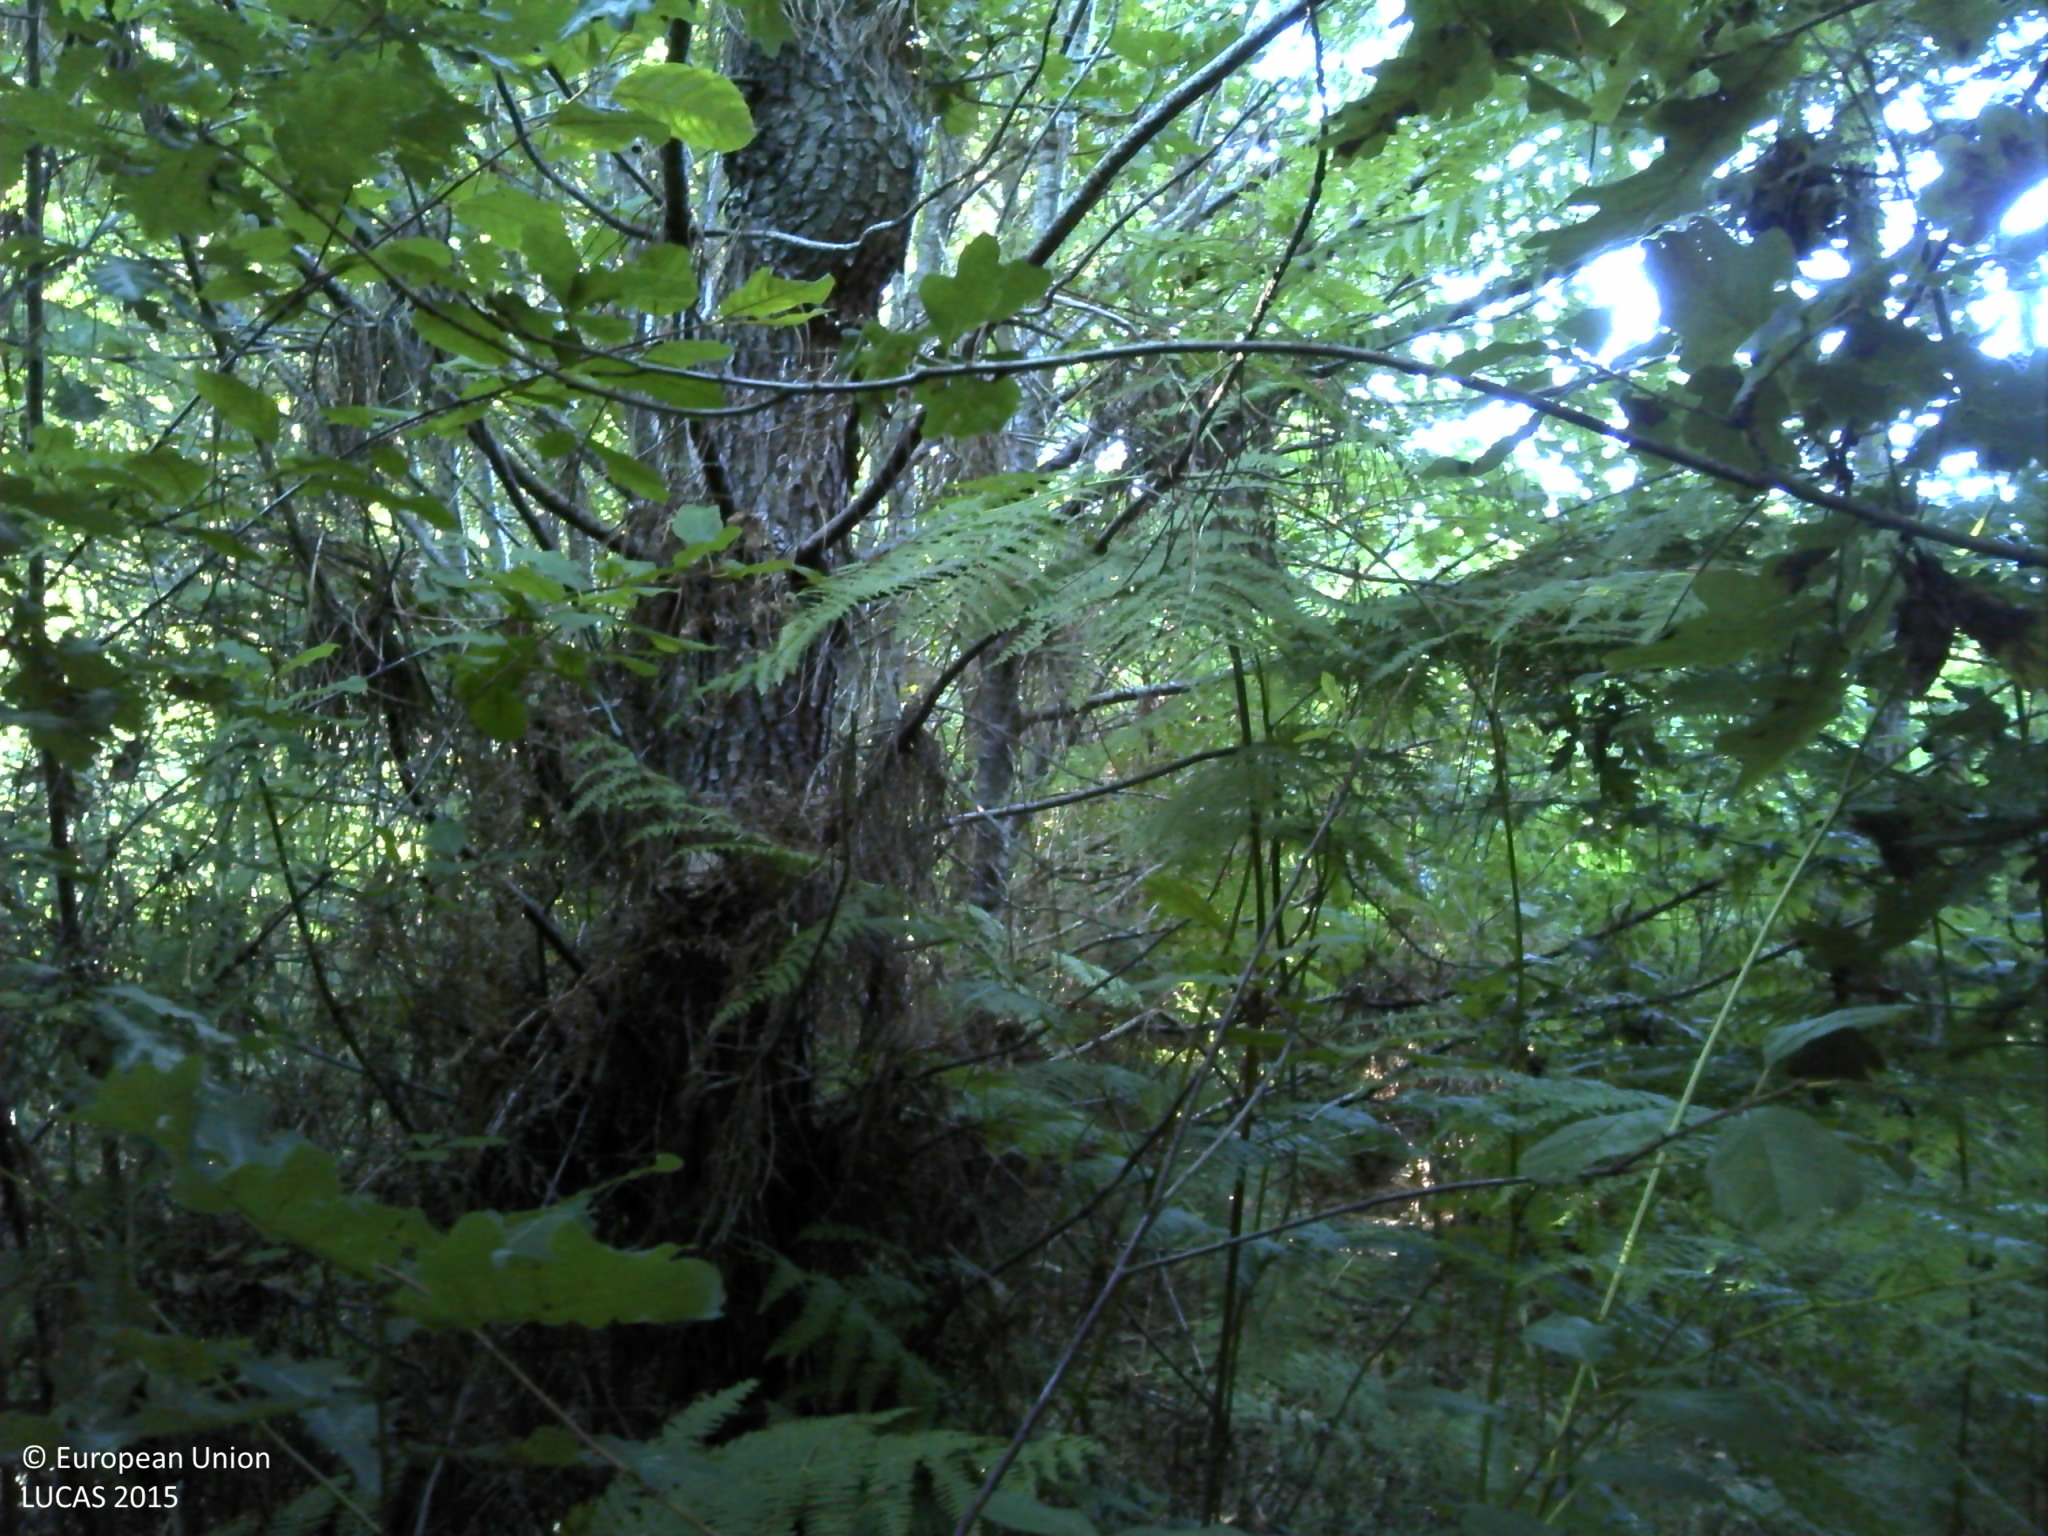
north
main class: Woodland
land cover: Pine dominated mixed woodland
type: coniferous forest of the mediterranean region
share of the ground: > 75 %
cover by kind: coniferous forest trees 50 %, broadleaved forest trees 25 %, shrubs 25 %
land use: Forestry
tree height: > 5 m
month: July
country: FR
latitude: 44.9635
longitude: -0.6567
